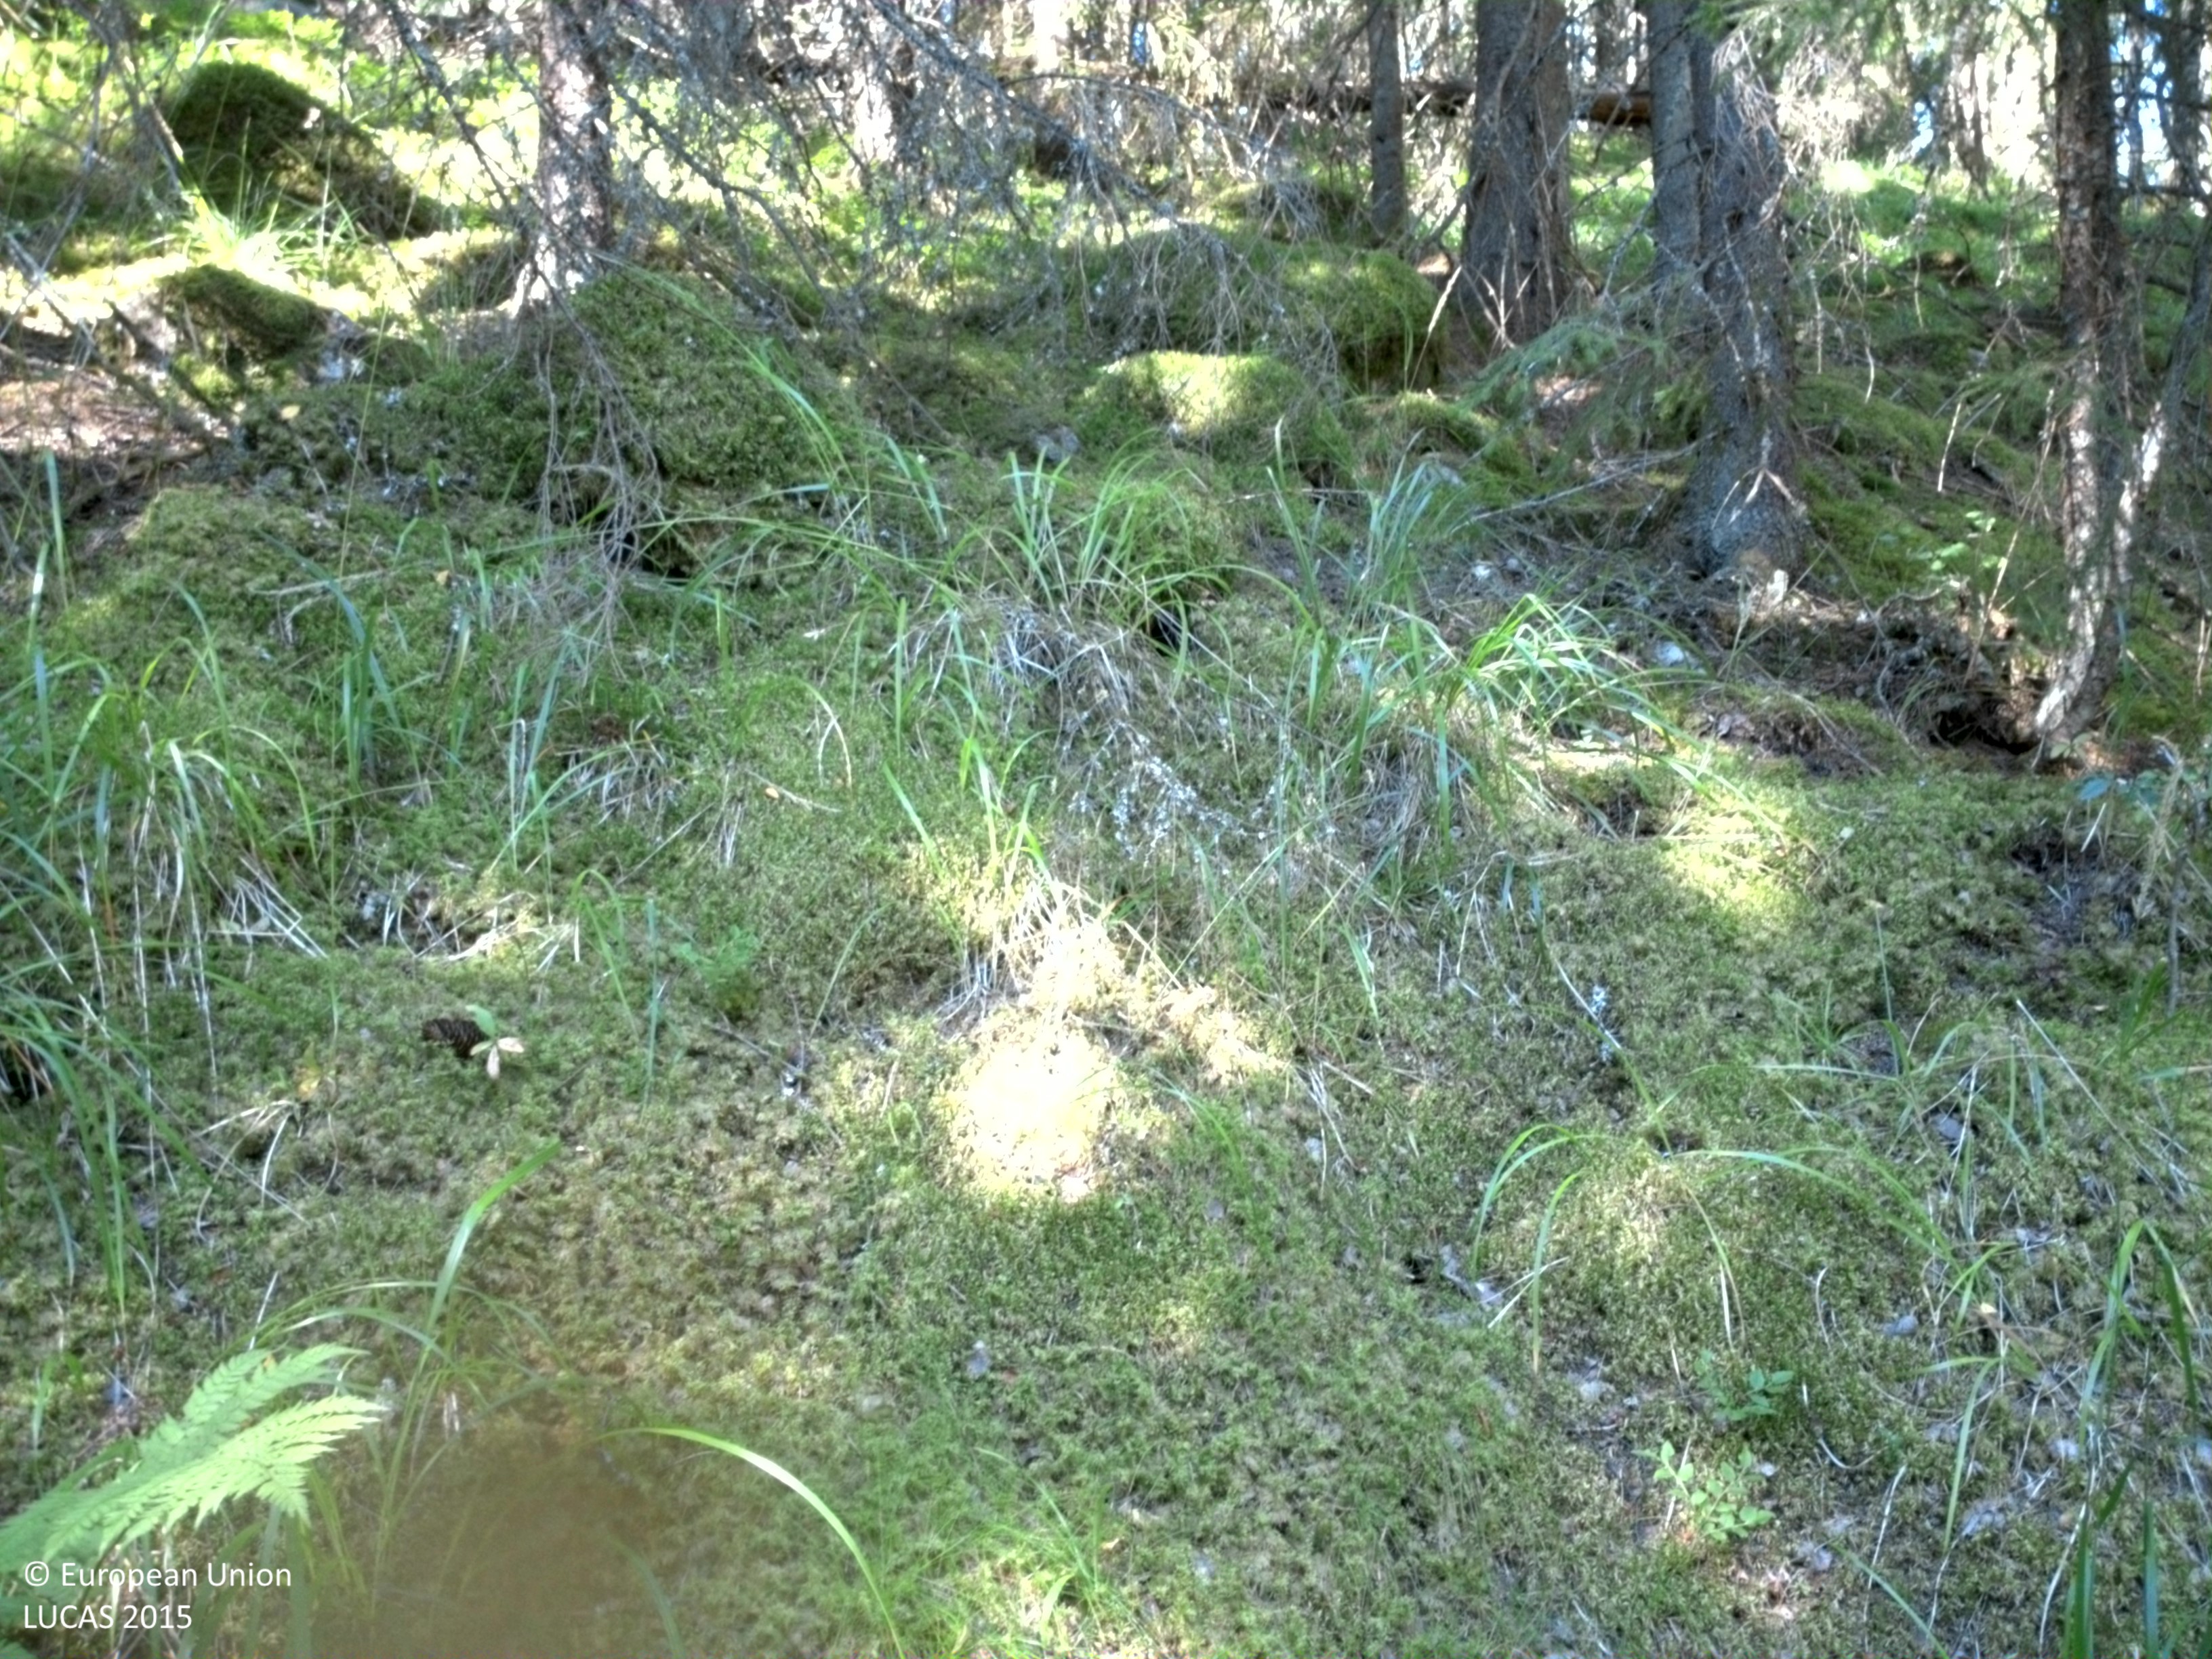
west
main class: Woodland
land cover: Spruce dominated coniferous woodland
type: boreal forest
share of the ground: 50 - 75 %
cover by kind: coniferous forest trees 65 %, lichens and mosses 15 %, shrubs 10 %, broadleaved forest trees 5 %, herbaceous plants 5 %
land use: Forestry
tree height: > 5 m
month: August
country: SE
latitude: 59.9079
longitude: 13.2993
